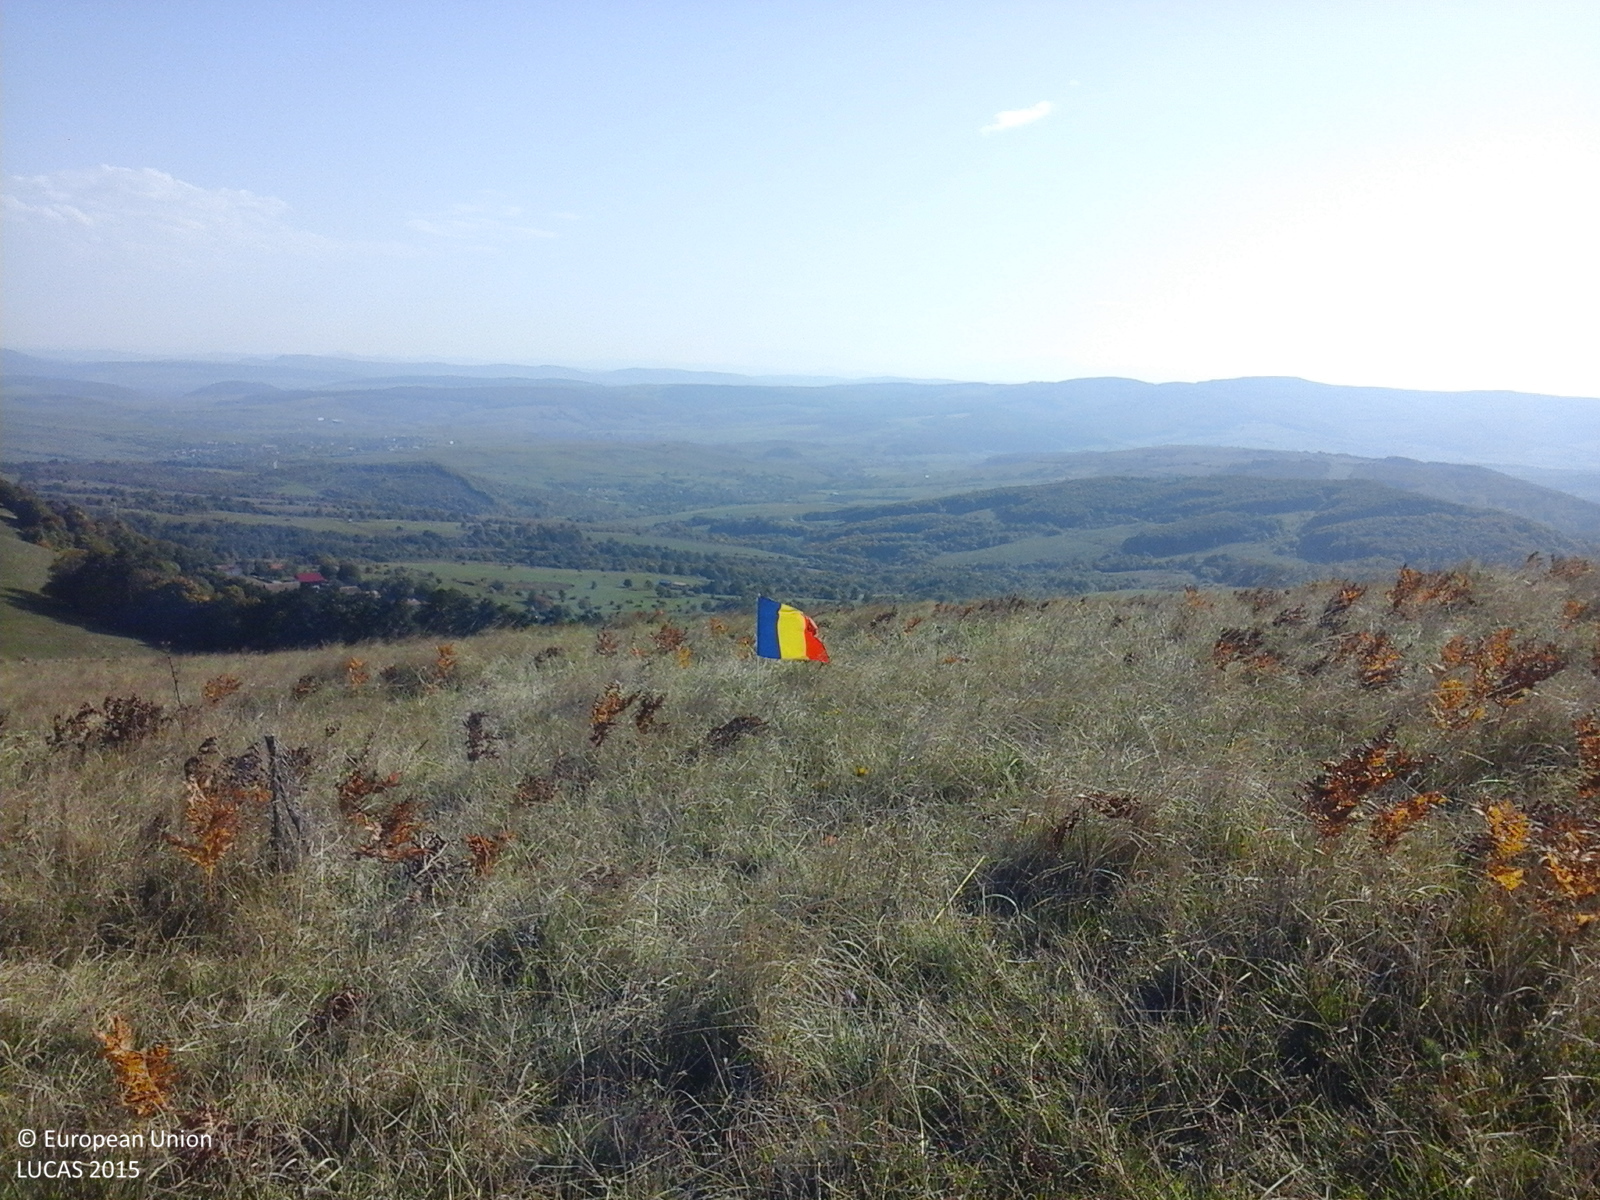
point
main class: Grassland
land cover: Grassland without tree/shrub cover
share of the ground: > 75 %
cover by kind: herbaceous plants 100 %
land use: Agriculture (excluding fallow land and kitchen gardens)
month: October
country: RO
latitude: 46.4314
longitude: 25.1841
